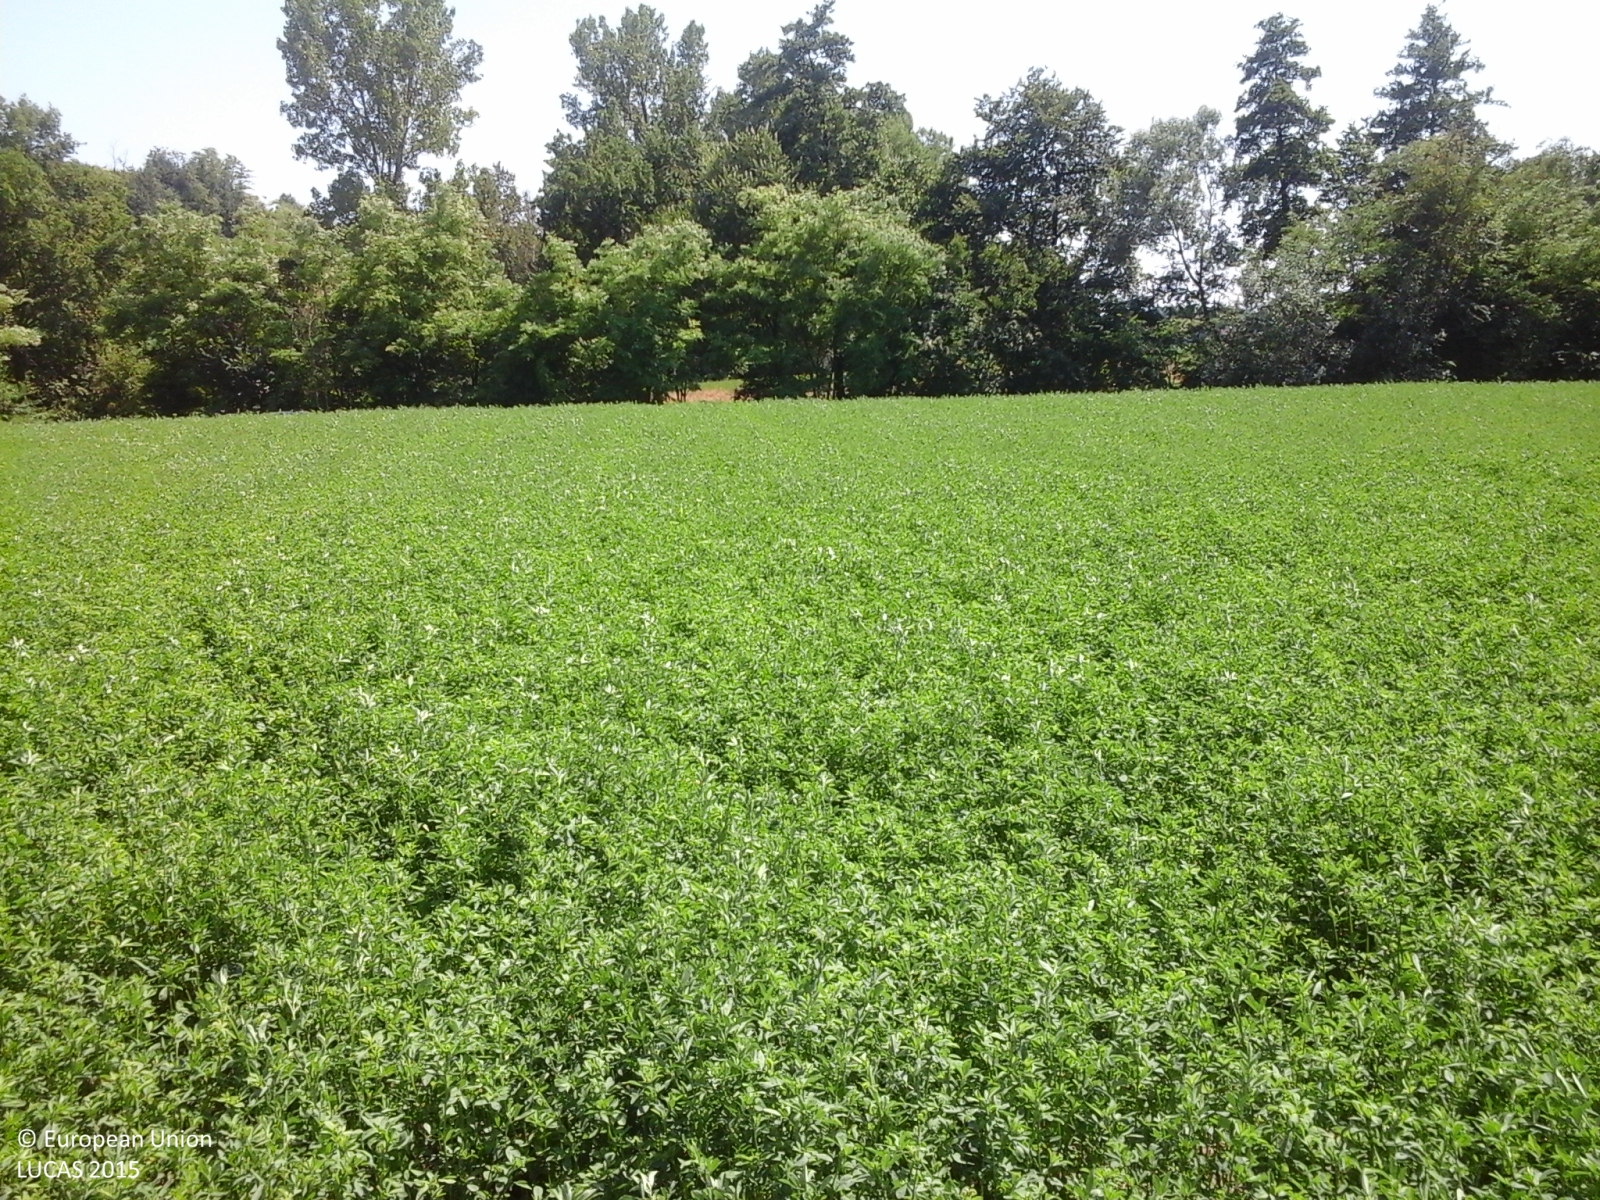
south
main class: Cropland
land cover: Lucerne
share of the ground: > 75 %
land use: Agriculture (excluding fallow land and kitchen gardens)
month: June
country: IT
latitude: 45.0390
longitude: 8.2387
